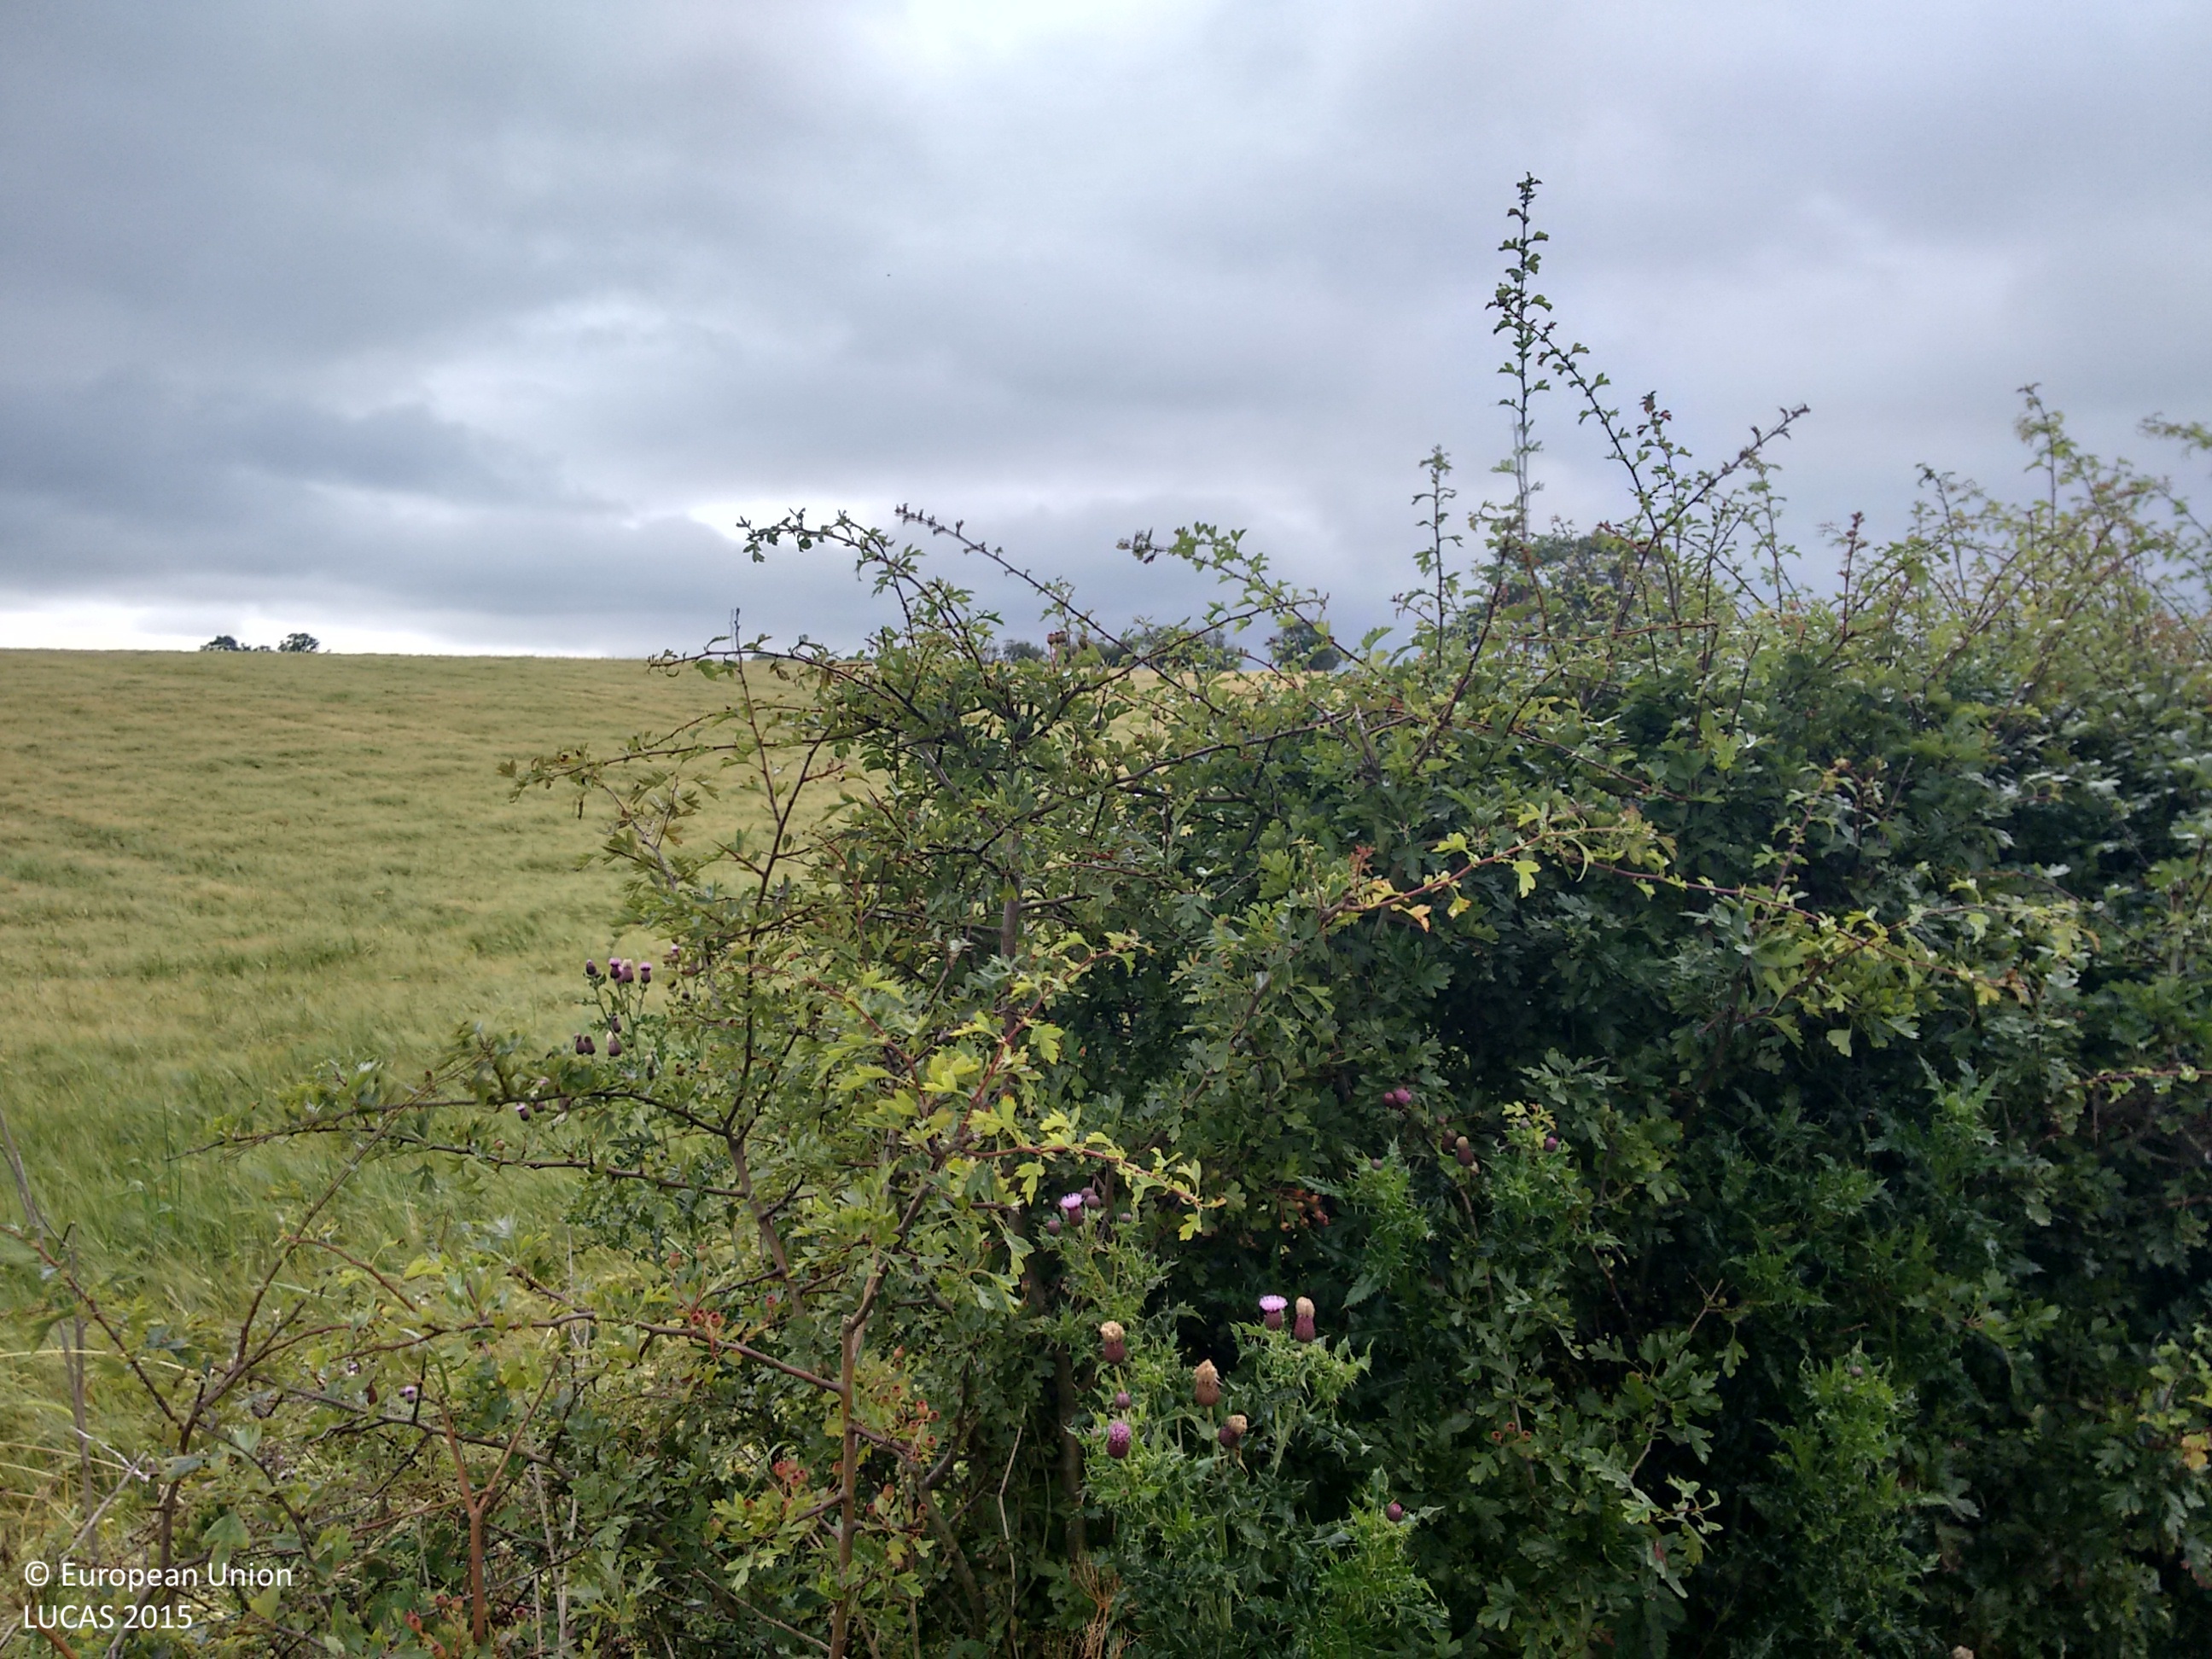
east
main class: Cropland
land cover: Barley
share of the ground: > 75 %
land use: Agriculture (excluding fallow land and kitchen gardens)
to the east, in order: Barley; Fences; Managed hedges; Arable land (only in case pi)
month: August
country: GB
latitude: 54.7537
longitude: -2.8570
